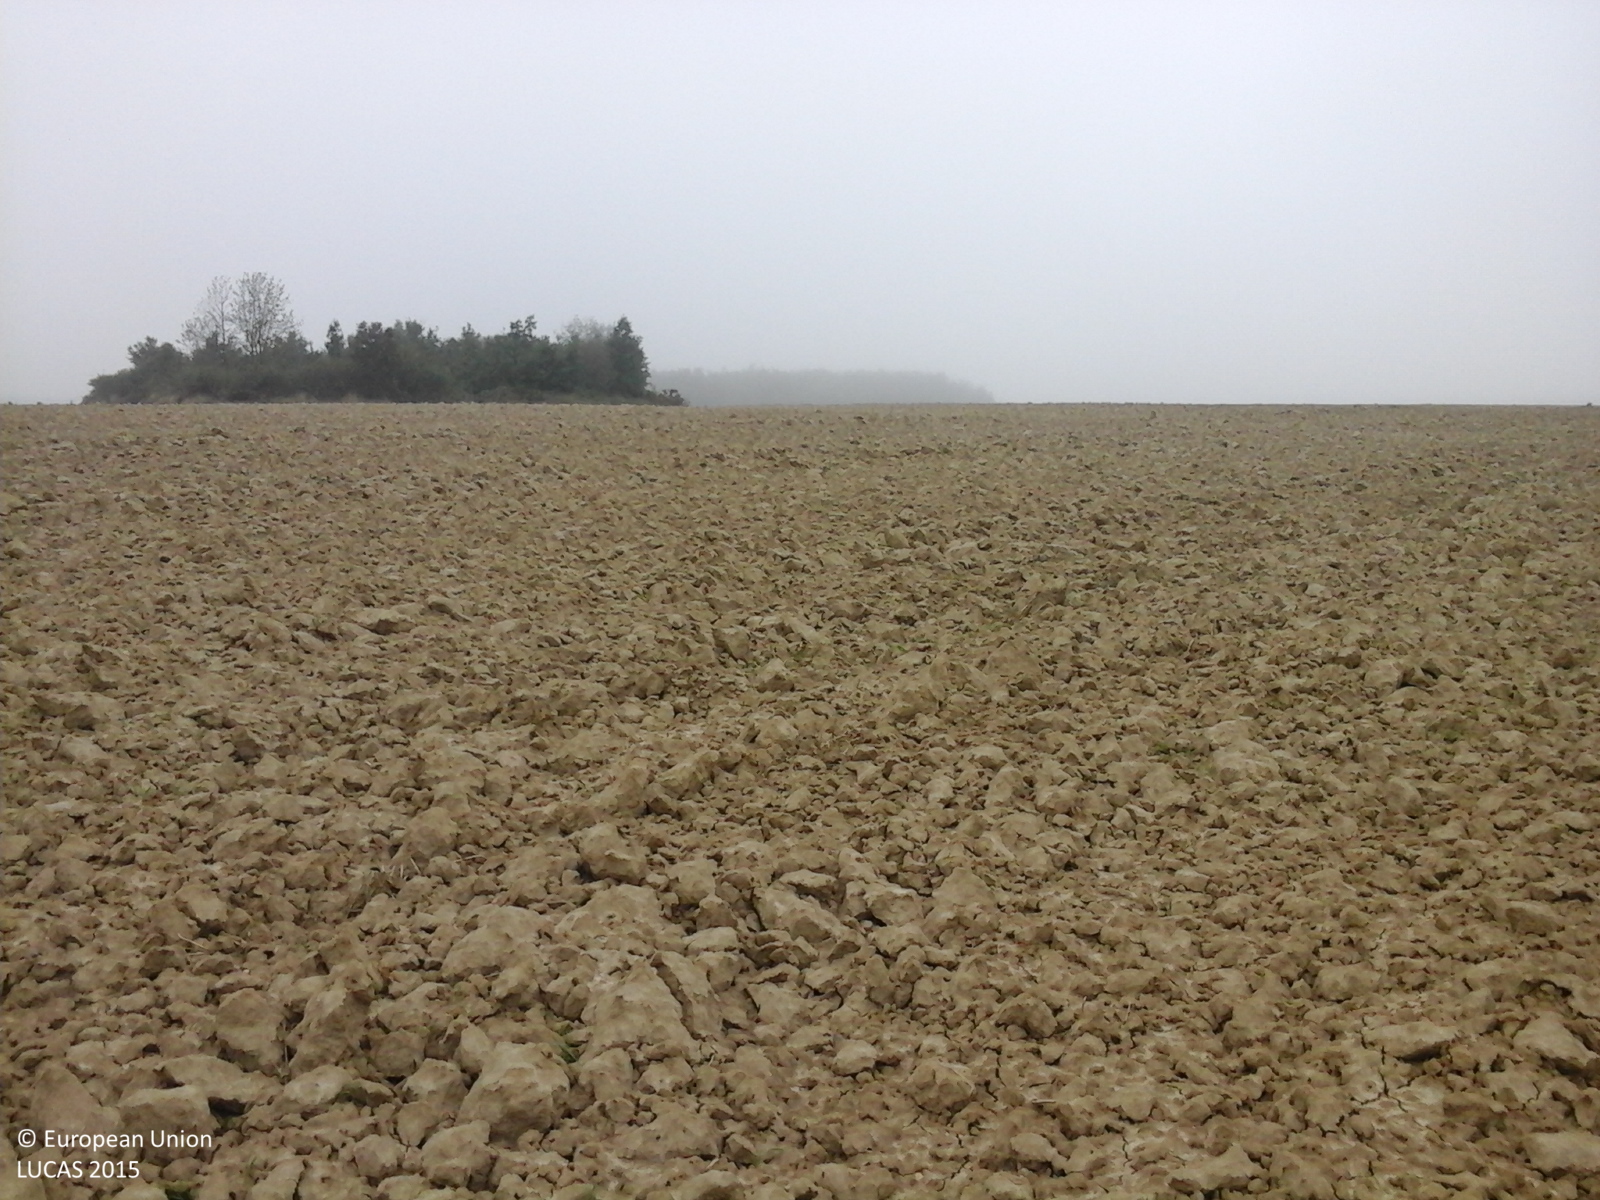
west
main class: Cropland
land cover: Common wheat
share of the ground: < 10 %
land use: Agriculture (excluding fallow land and kitchen gardens)
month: September
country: RO
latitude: 45.5616
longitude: 22.0180
